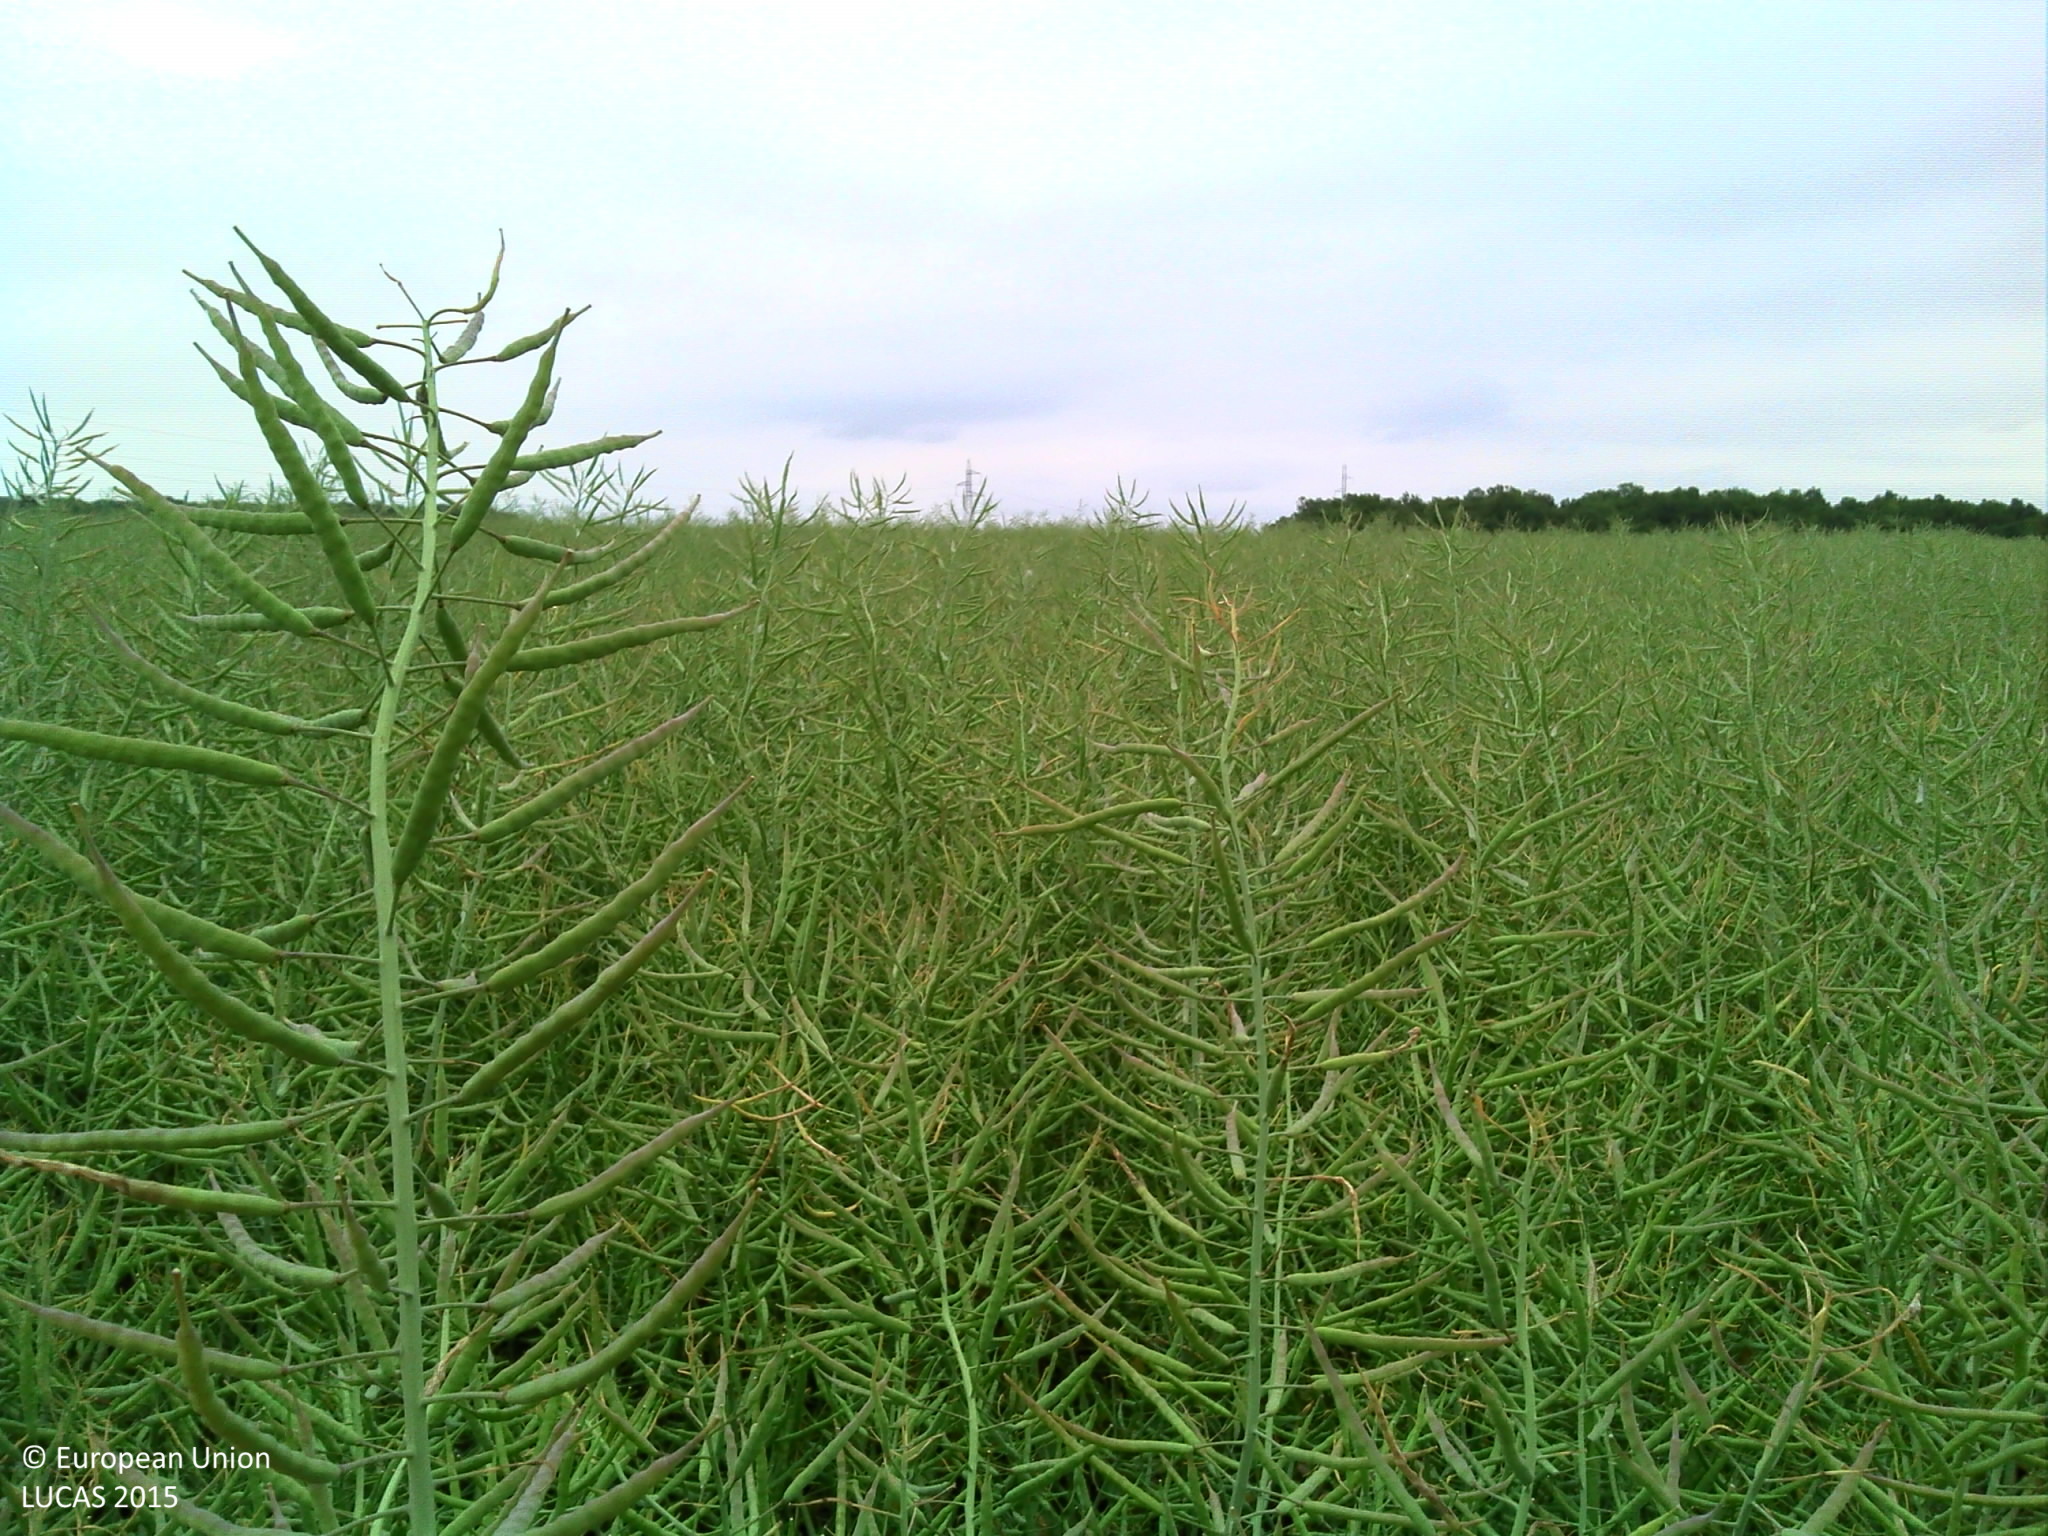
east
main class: Cropland
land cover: Rape and turnip rape
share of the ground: > 75 %
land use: Agriculture (excluding fallow land and kitchen gardens)
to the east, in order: Rape and turnip rape; Grass margins; Tracks; Grass margins; Rape and turnip rape
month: May
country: FR
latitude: 47.1266
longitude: 2.8896
